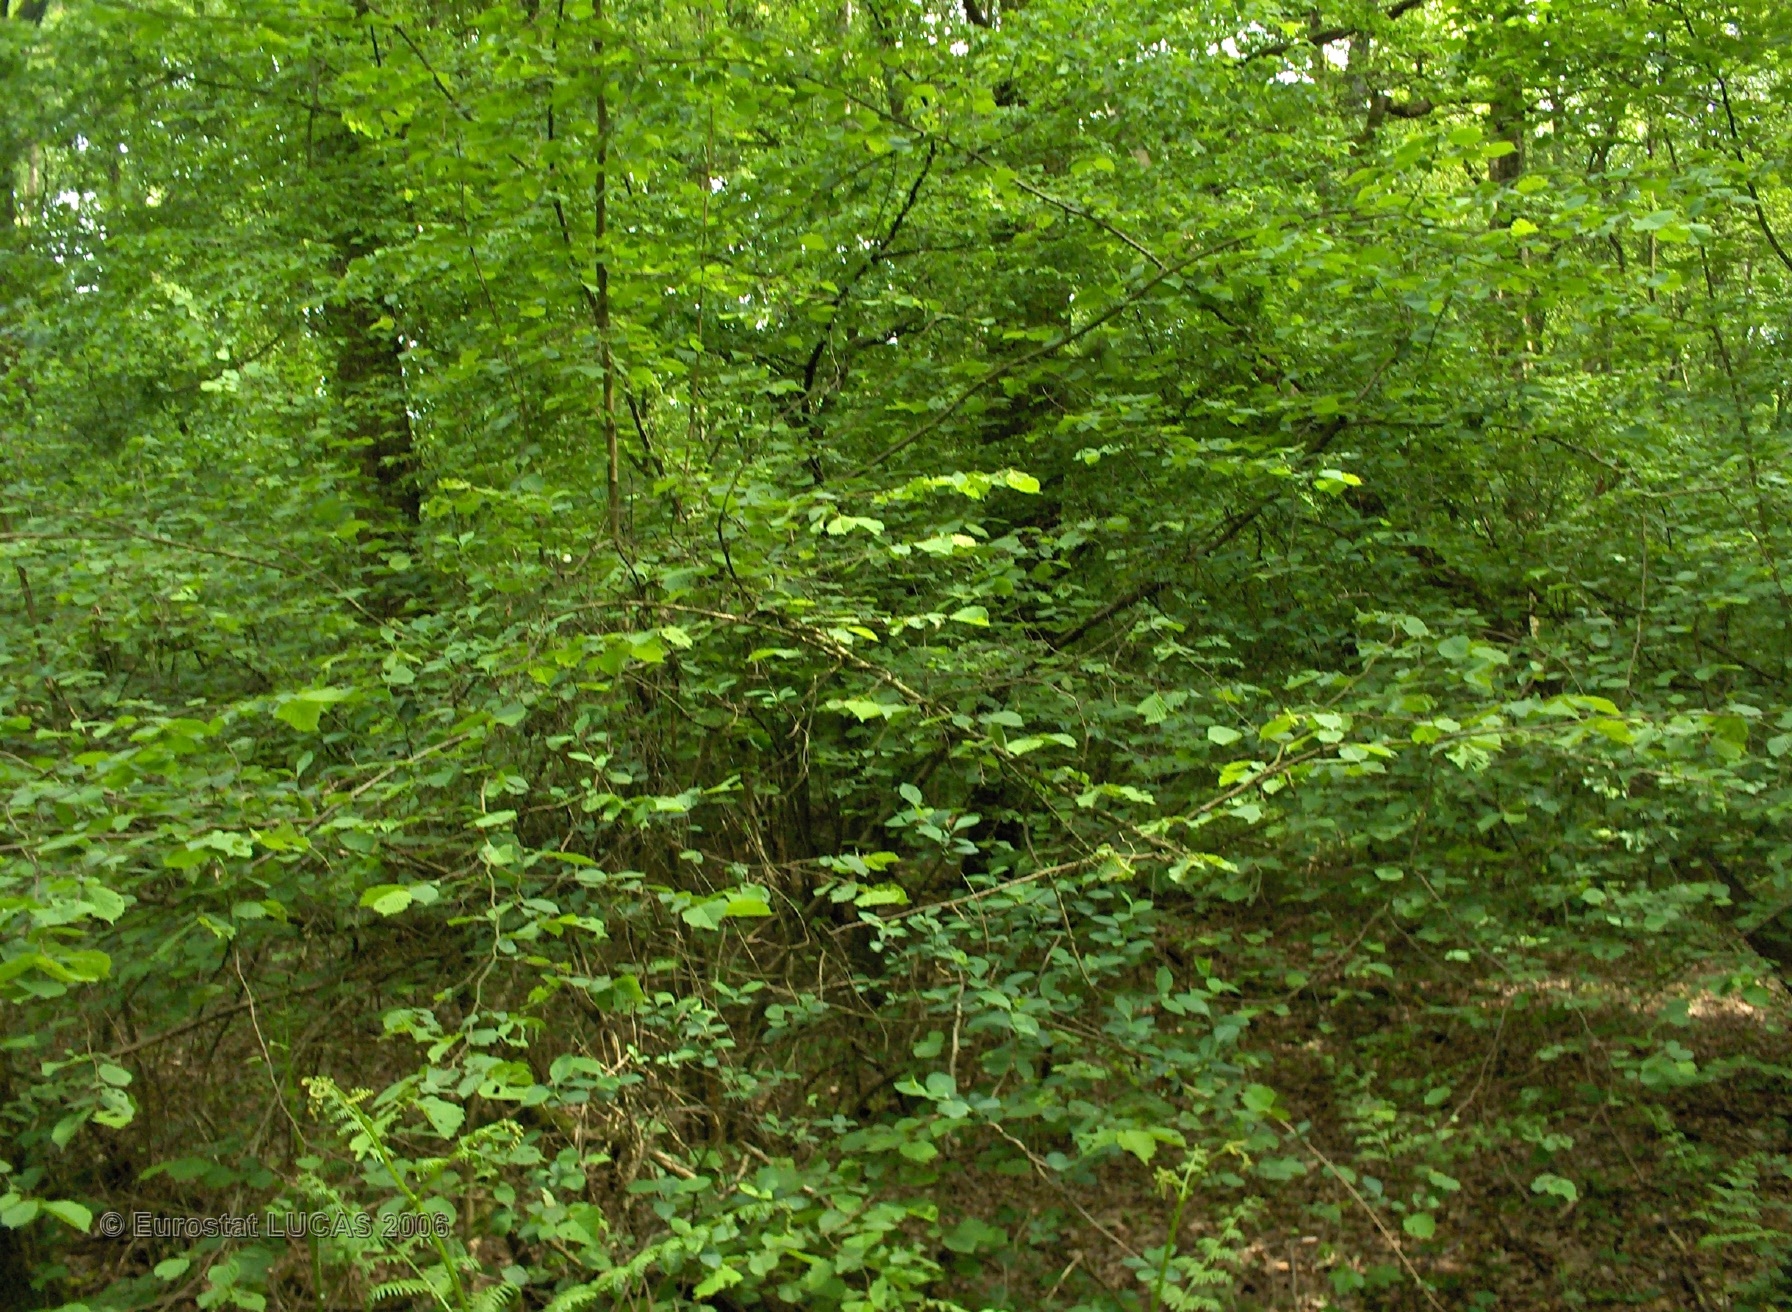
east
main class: Woodland
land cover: Broadleaved forest
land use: Forestry
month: June
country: BE
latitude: 50.2172
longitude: 4.5725
